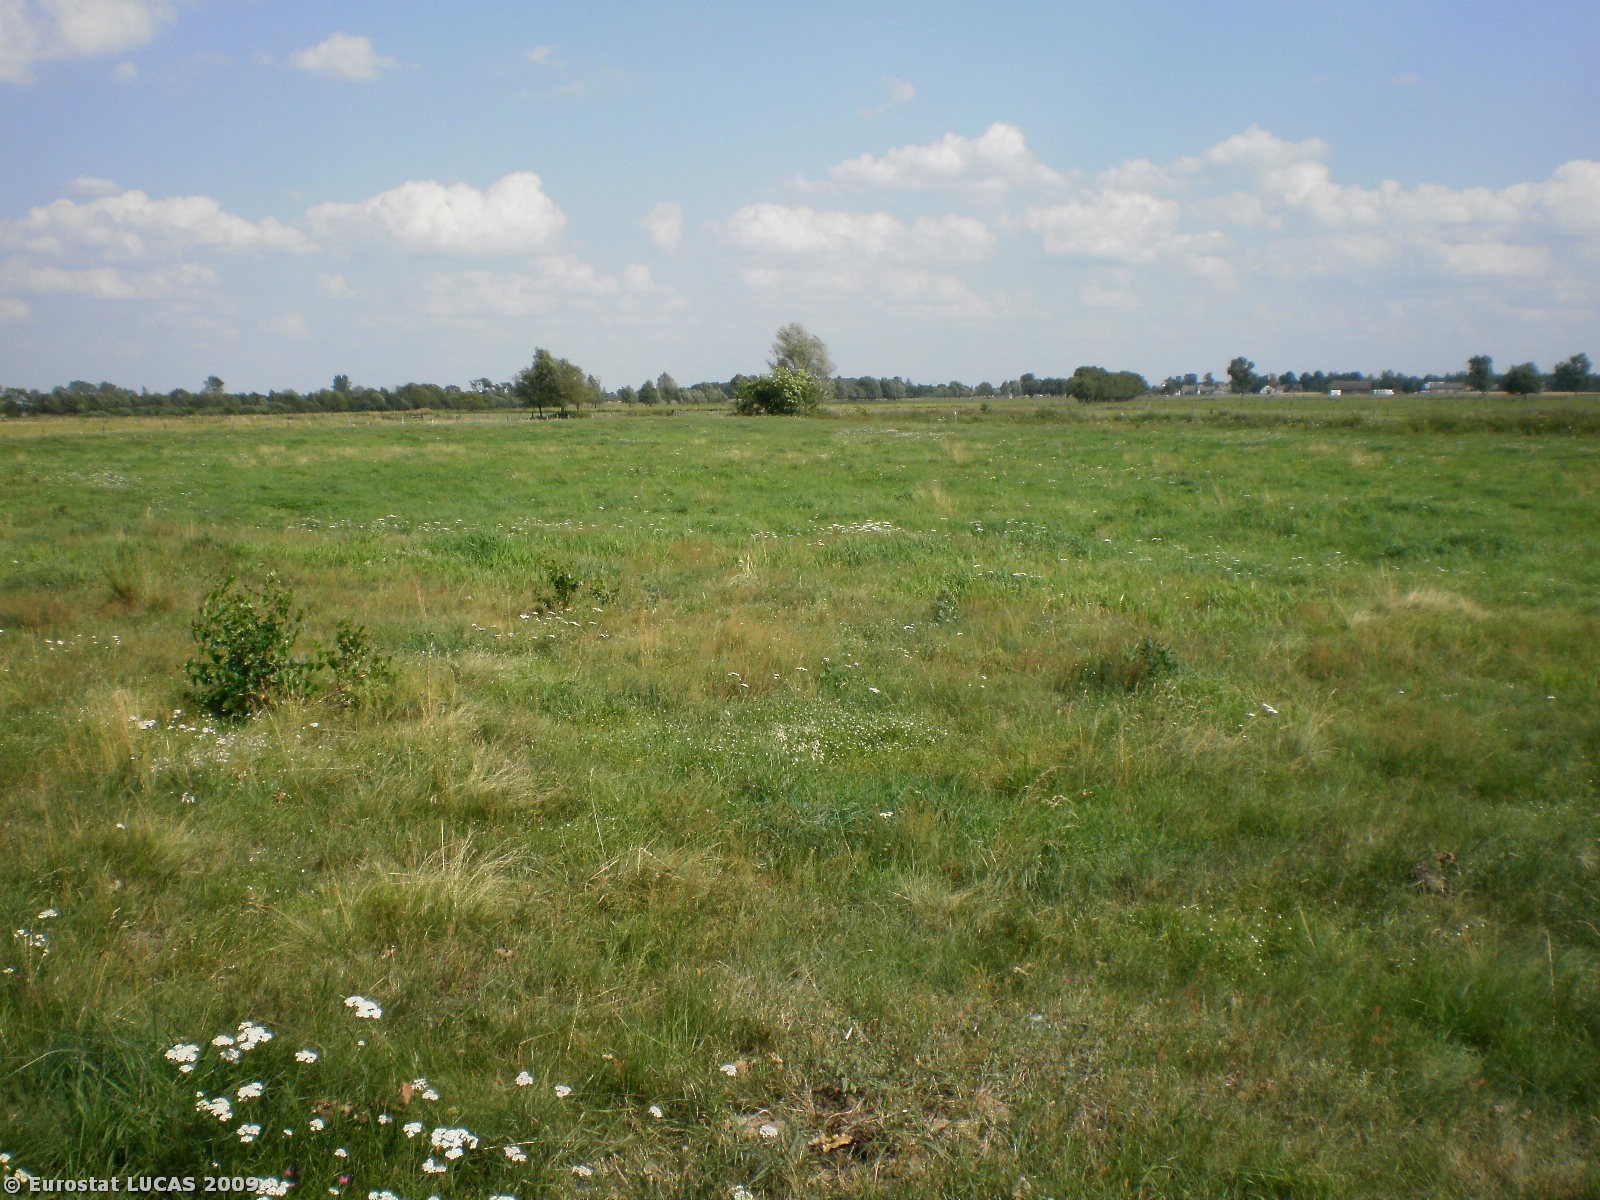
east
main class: Grassland
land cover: Grassland without tree/shrub cover
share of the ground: > 75 %
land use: Agriculture (excluding fallow land and kitchen gardens)
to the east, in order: Grassland without tree/shrub cover; Fences; Grassland without tree/shrub cover; Fences; Grassland without tree/shrub cover; Ditches and canals; Grass margins; Tracks; Grass margins; Single bushes/trees; Grassland without tree/shrub cover
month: July
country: PL
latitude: 53.2824
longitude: 20.9774
